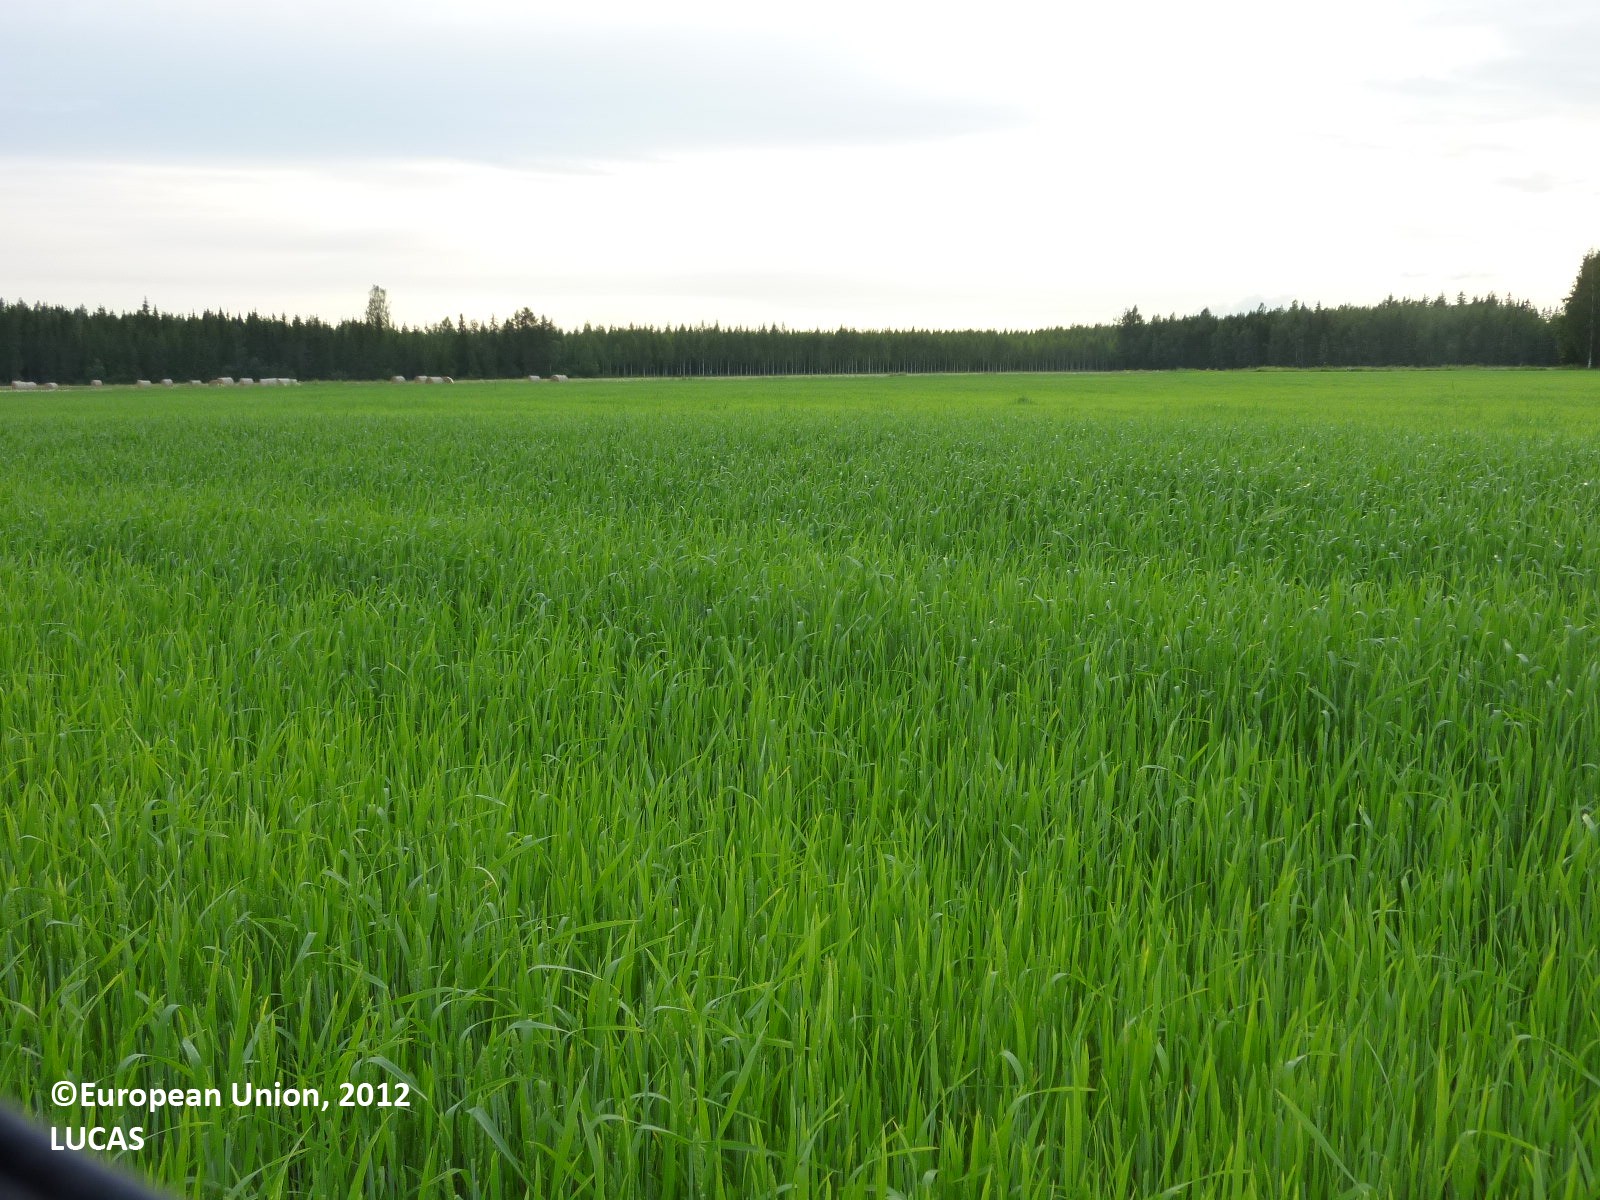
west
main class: Cropland
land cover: Common wheat
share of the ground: > 75 %
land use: Agriculture (excluding fallow land and kitchen gardens)
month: July
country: FI
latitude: 61.4156
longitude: 22.0299
